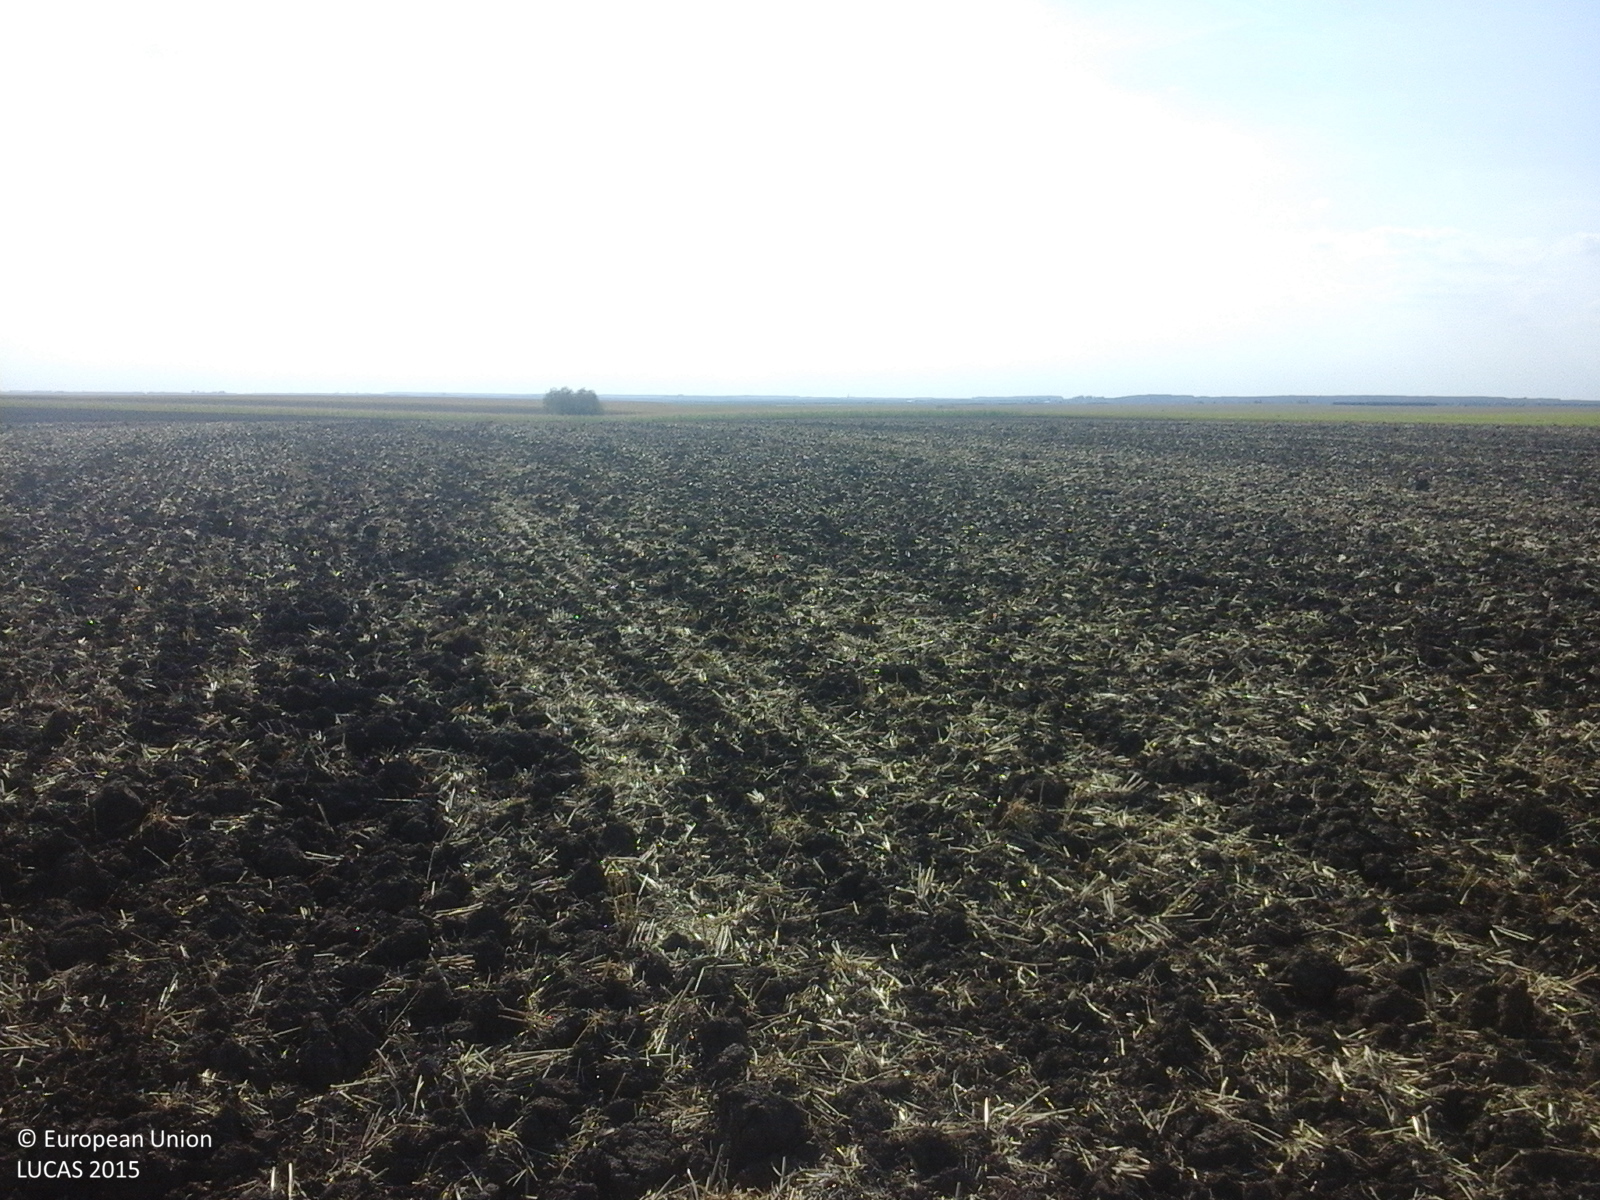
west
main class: Cropland
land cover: Common wheat
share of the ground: < 10 %
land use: Agriculture (excluding fallow land and kitchen gardens)
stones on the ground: < 10 %
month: August
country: RO
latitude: 45.3928
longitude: 21.4117
